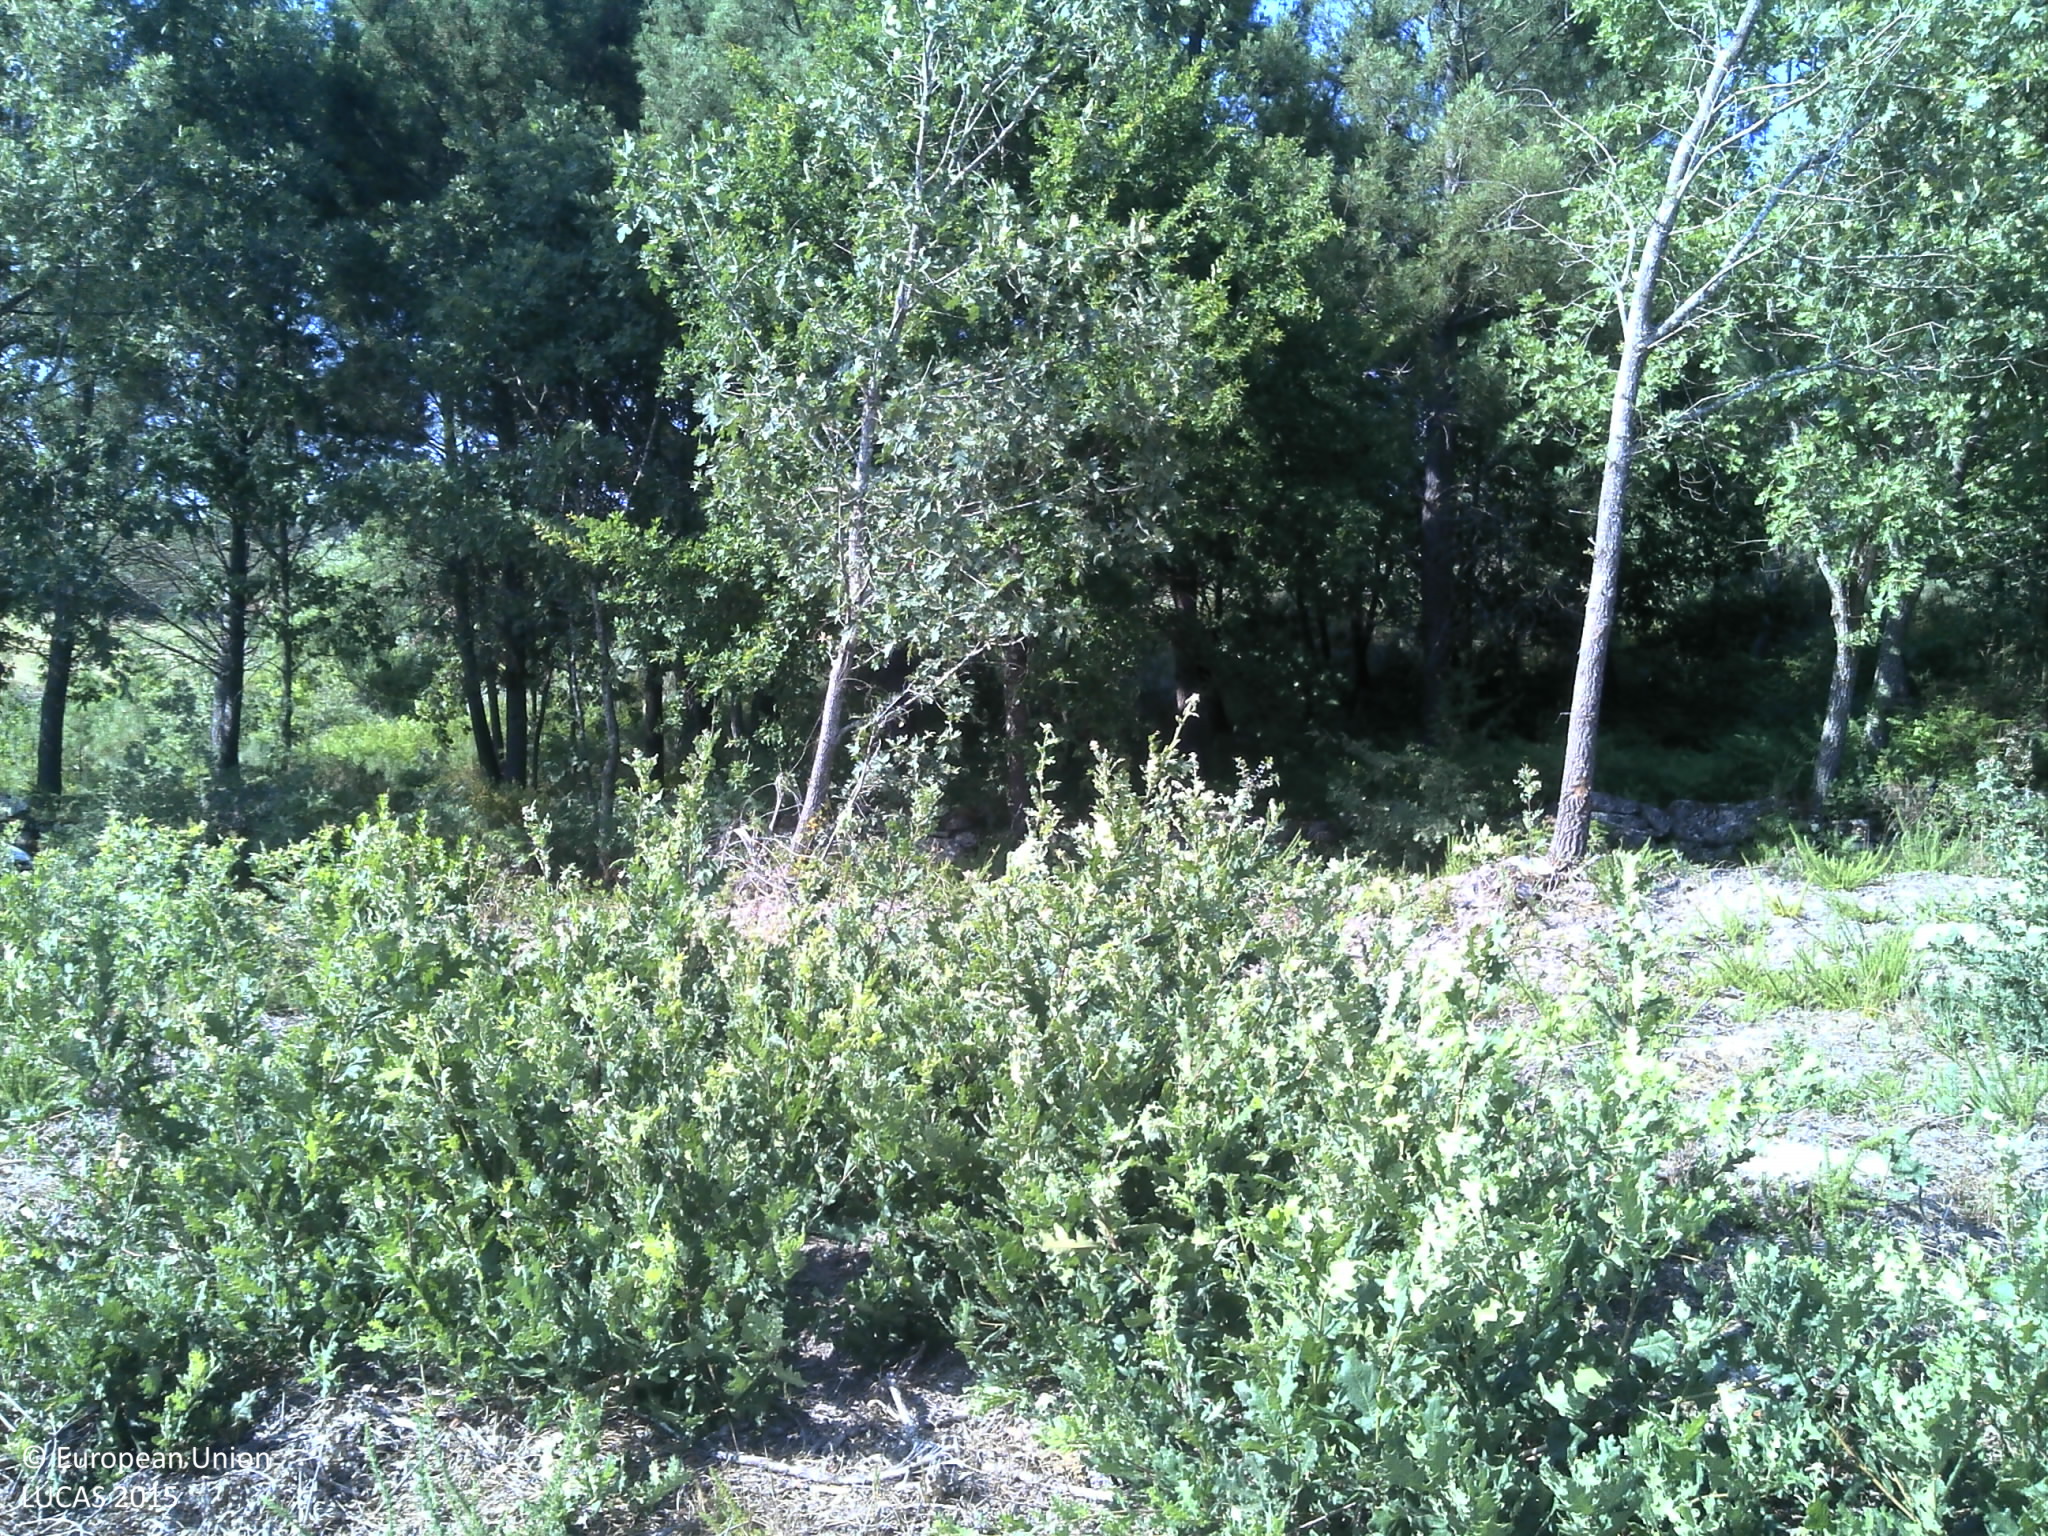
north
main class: Shrubland
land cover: Shrubland with sparse tree cover
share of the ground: 50 - 75 %
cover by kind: shrubs 60 %, herbaceous plants 30 %, broadleaved forest trees 5 %, unconsolidated bare surface 5 %
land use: Forestry
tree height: > 5 m
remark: Clear cut
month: June
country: PT
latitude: 40.4151
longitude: -7.8066
